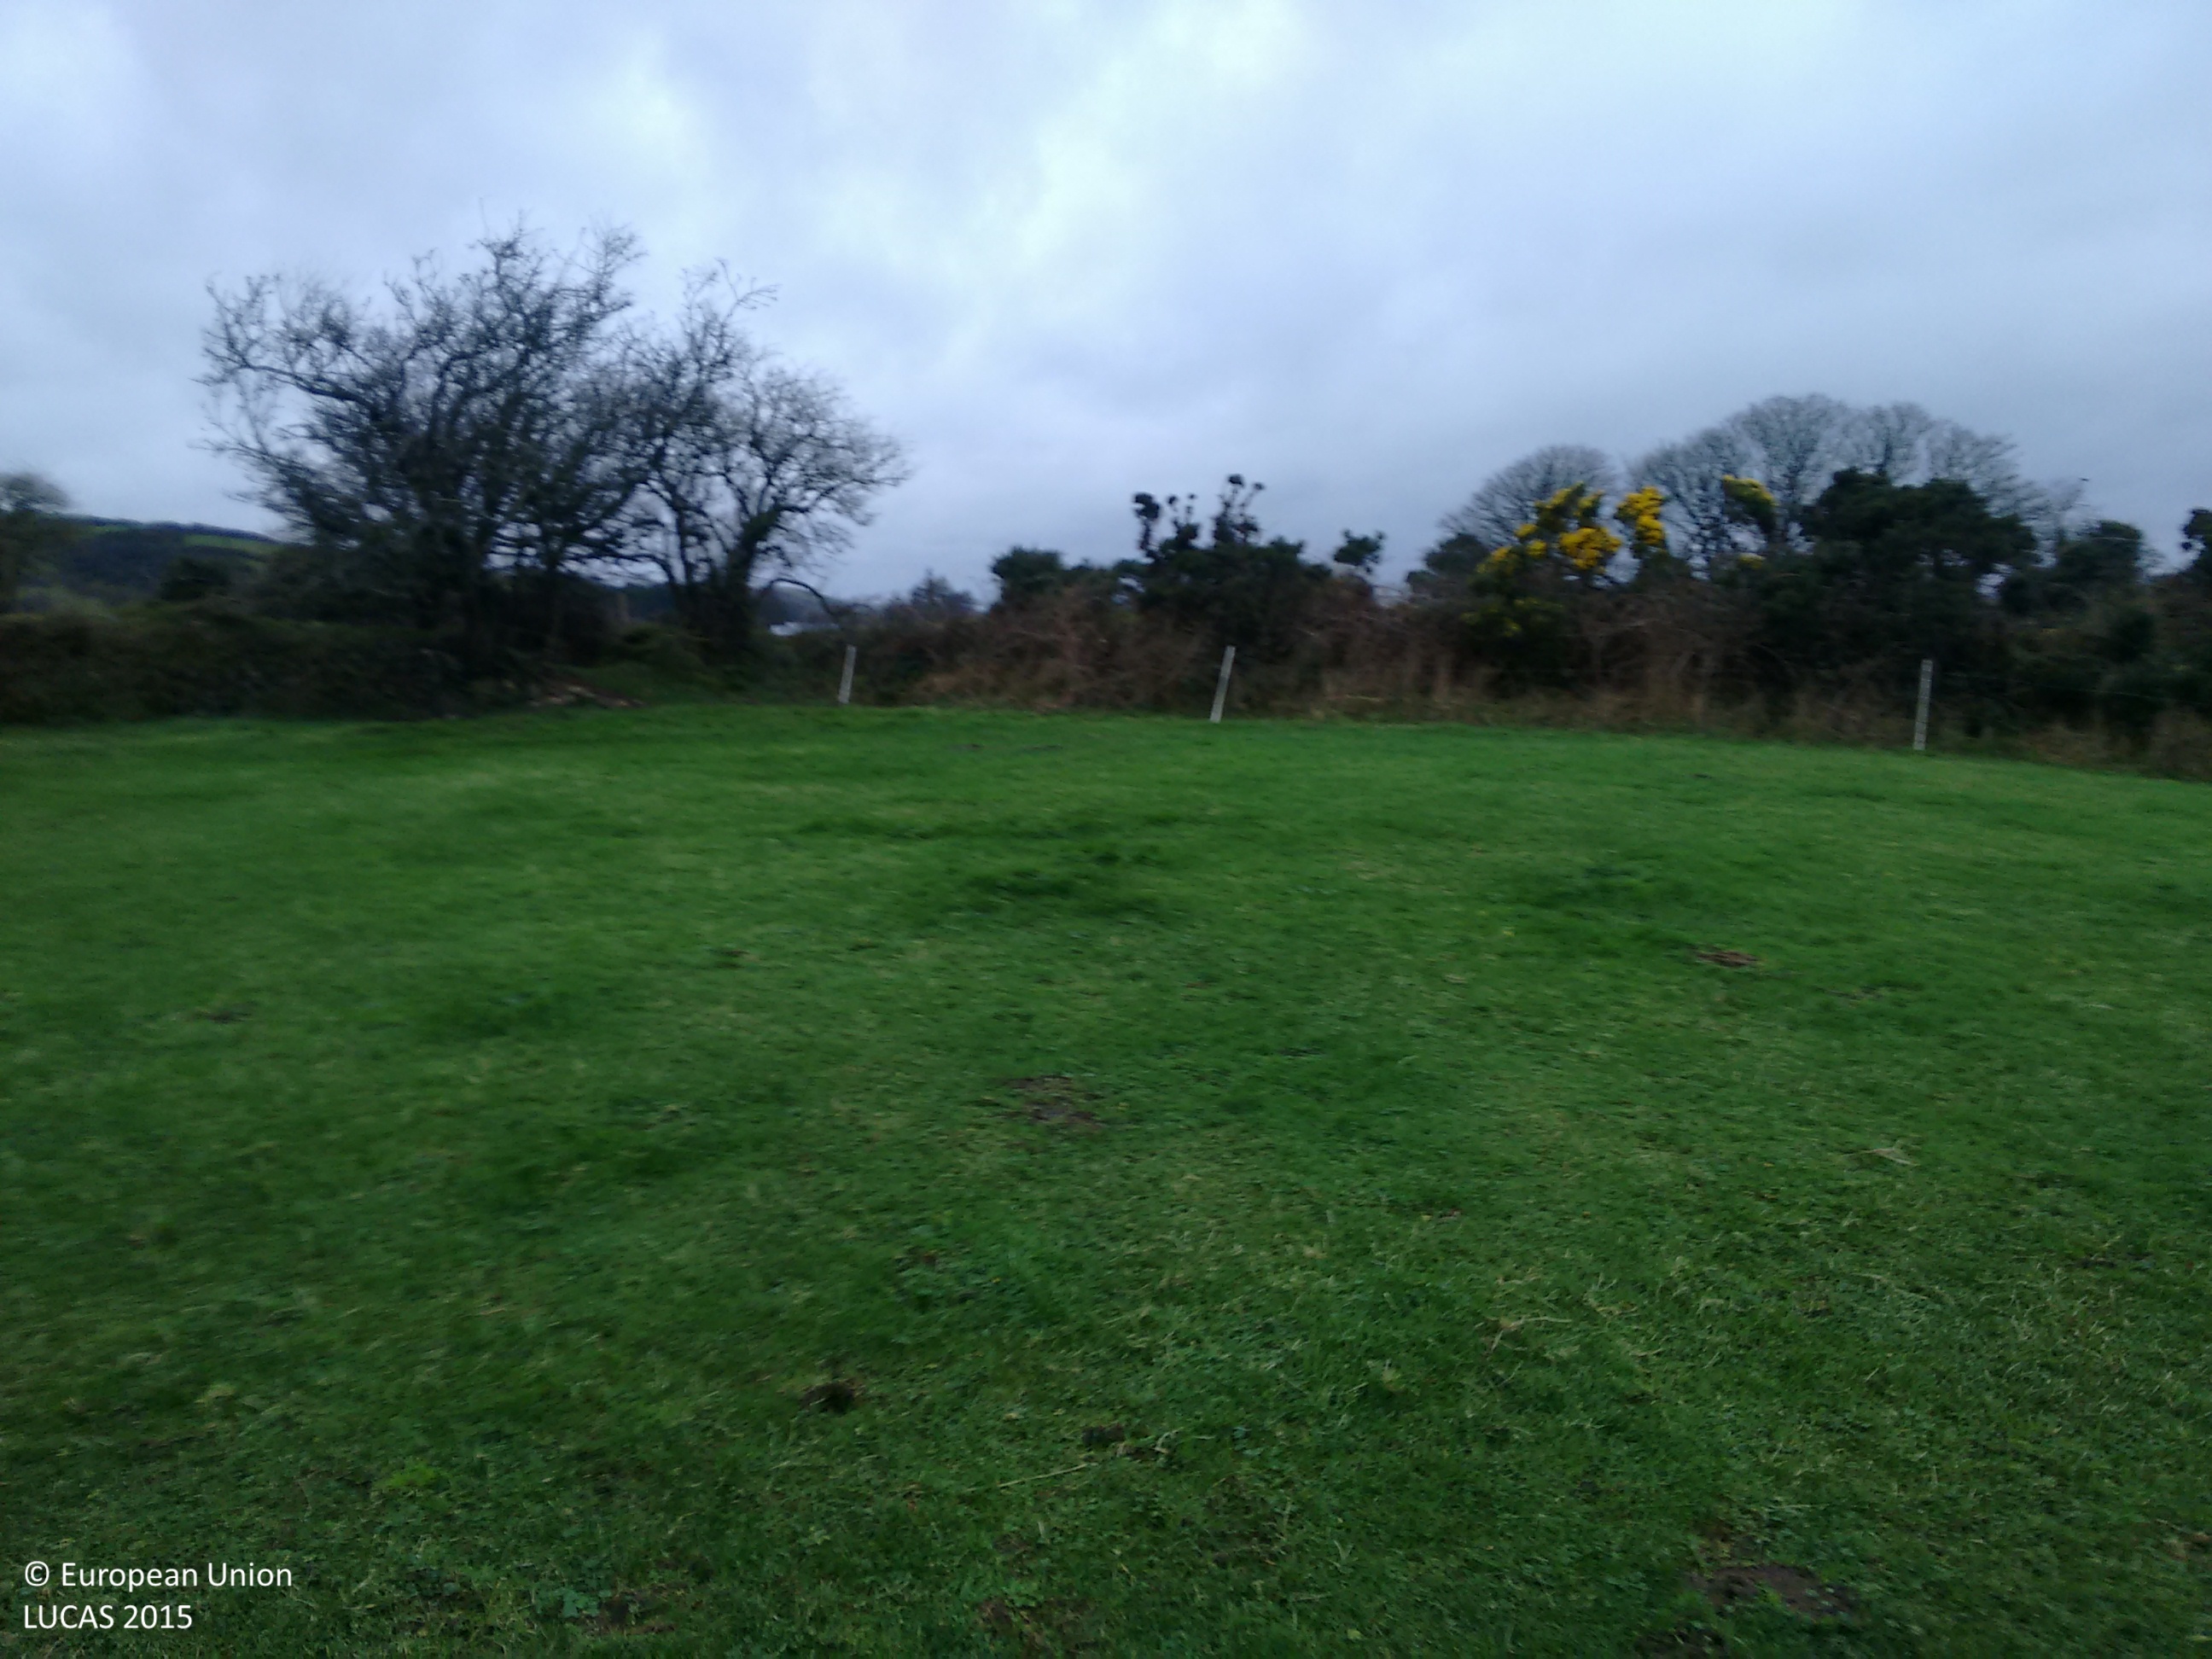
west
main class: Grassland
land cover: Grassland without tree/shrub cover
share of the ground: > 75 %
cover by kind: herbaceous plants 100 %
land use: Agriculture (excluding fallow land and kitchen gardens)
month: December
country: IE
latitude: 53.9342
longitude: -6.8767
